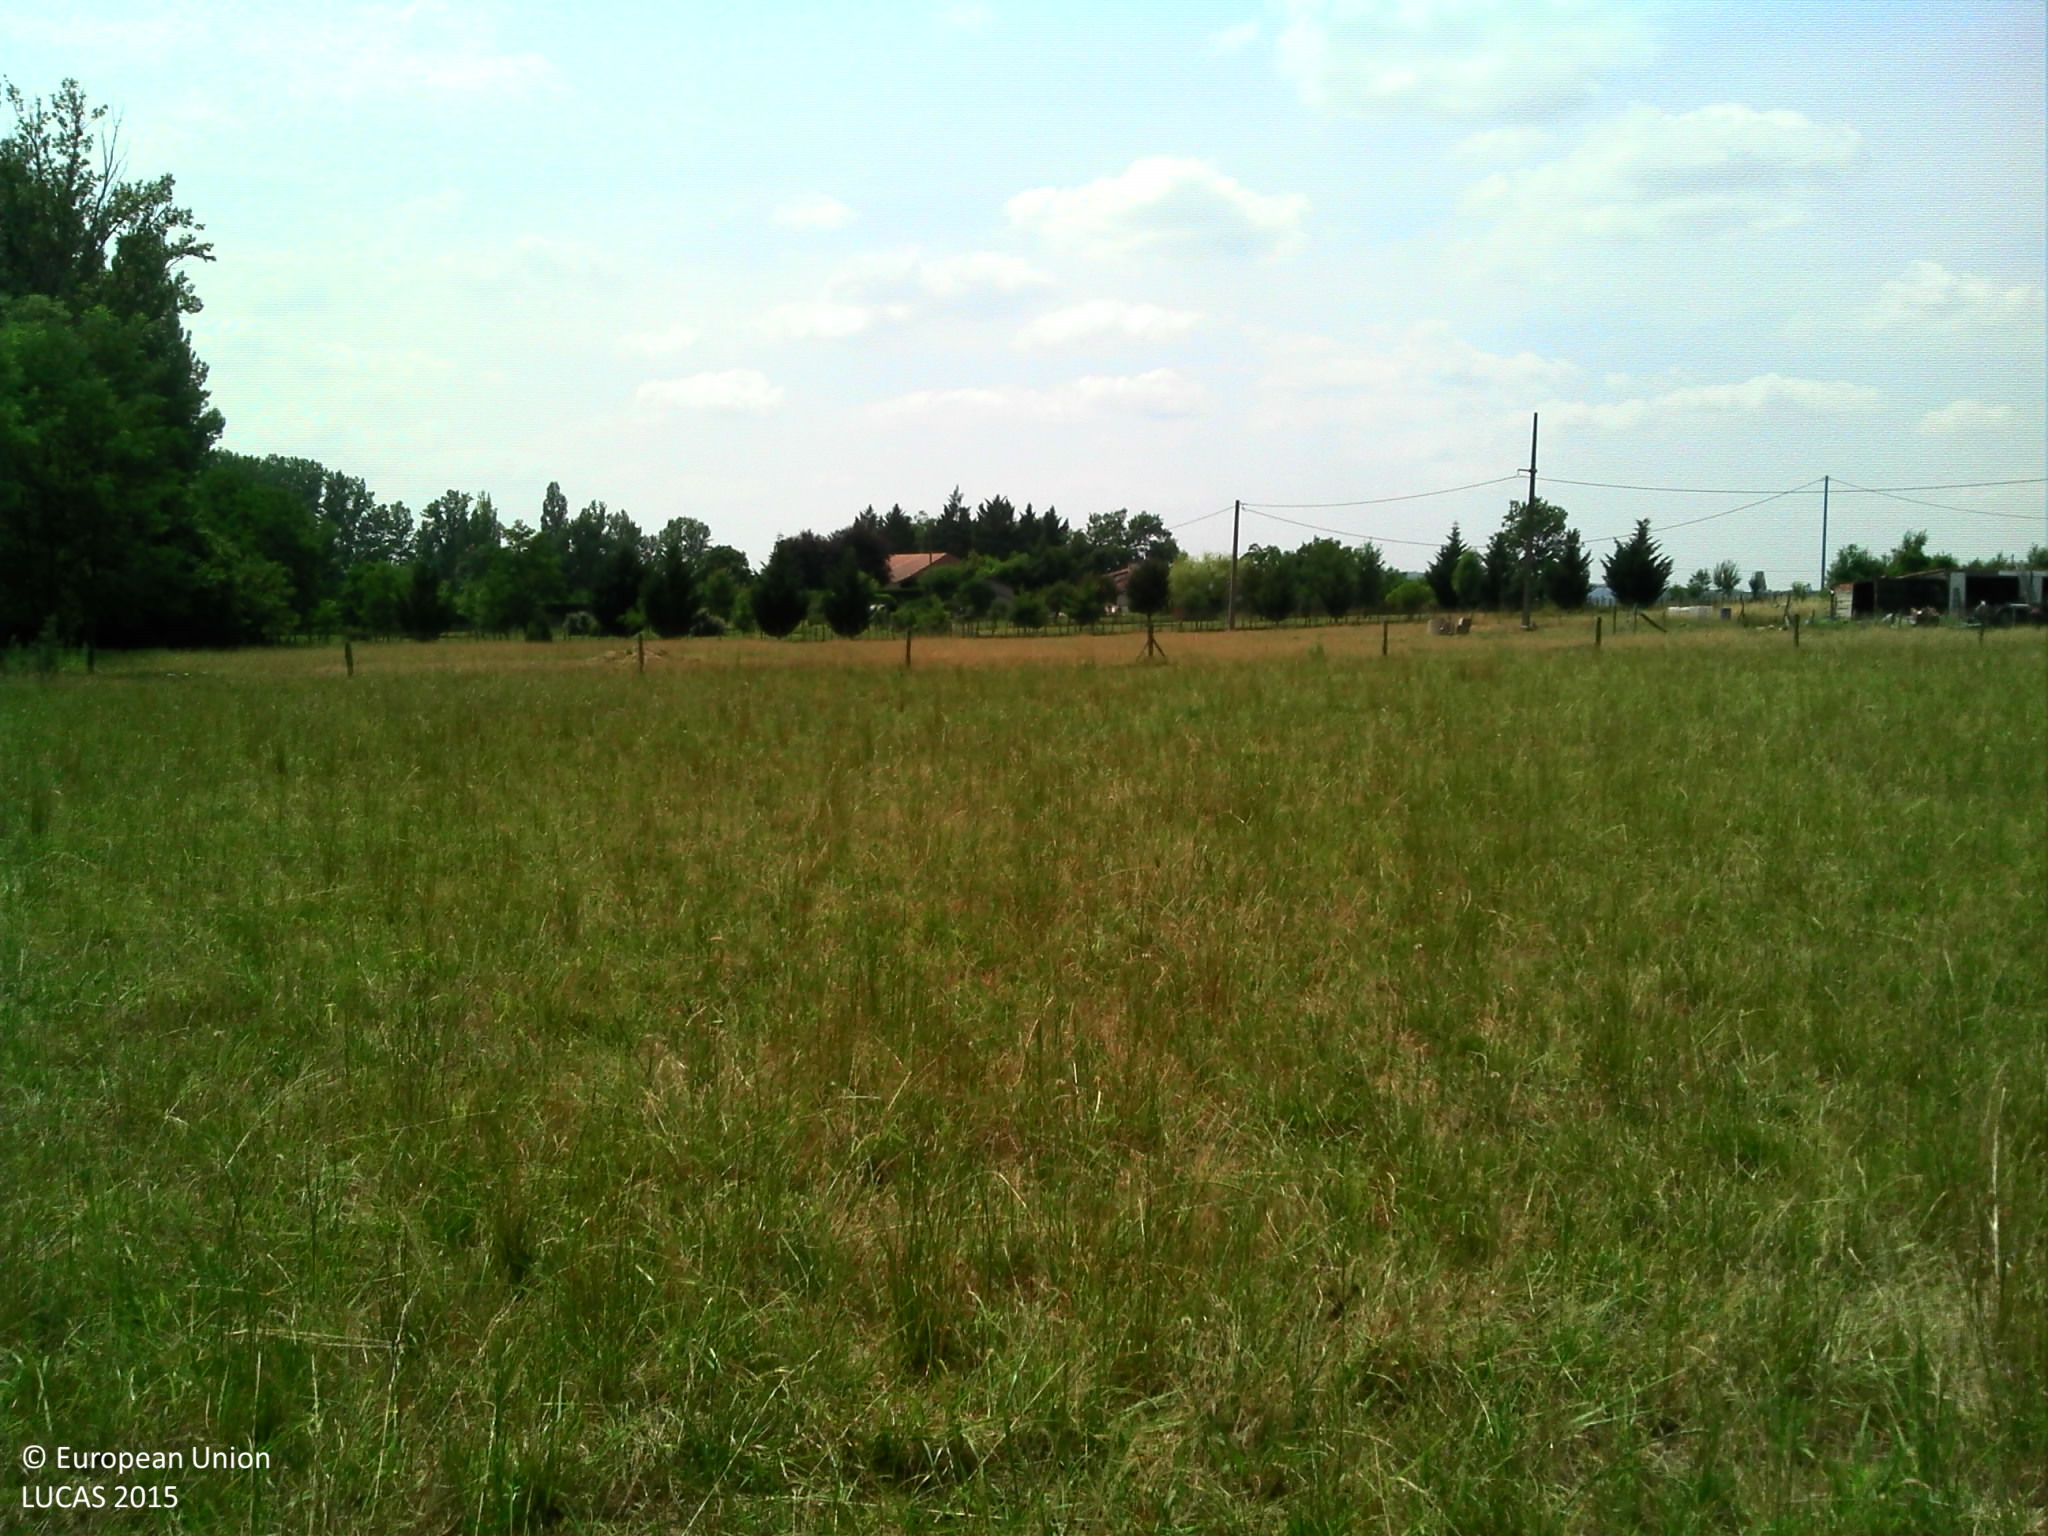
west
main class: Grassland
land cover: Grassland without tree/shrub cover
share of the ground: > 75 %
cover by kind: herbaceous plants 100 %
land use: Agriculture (excluding fallow land and kitchen gardens)
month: July
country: FR
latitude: 44.4185
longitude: 0.8643
